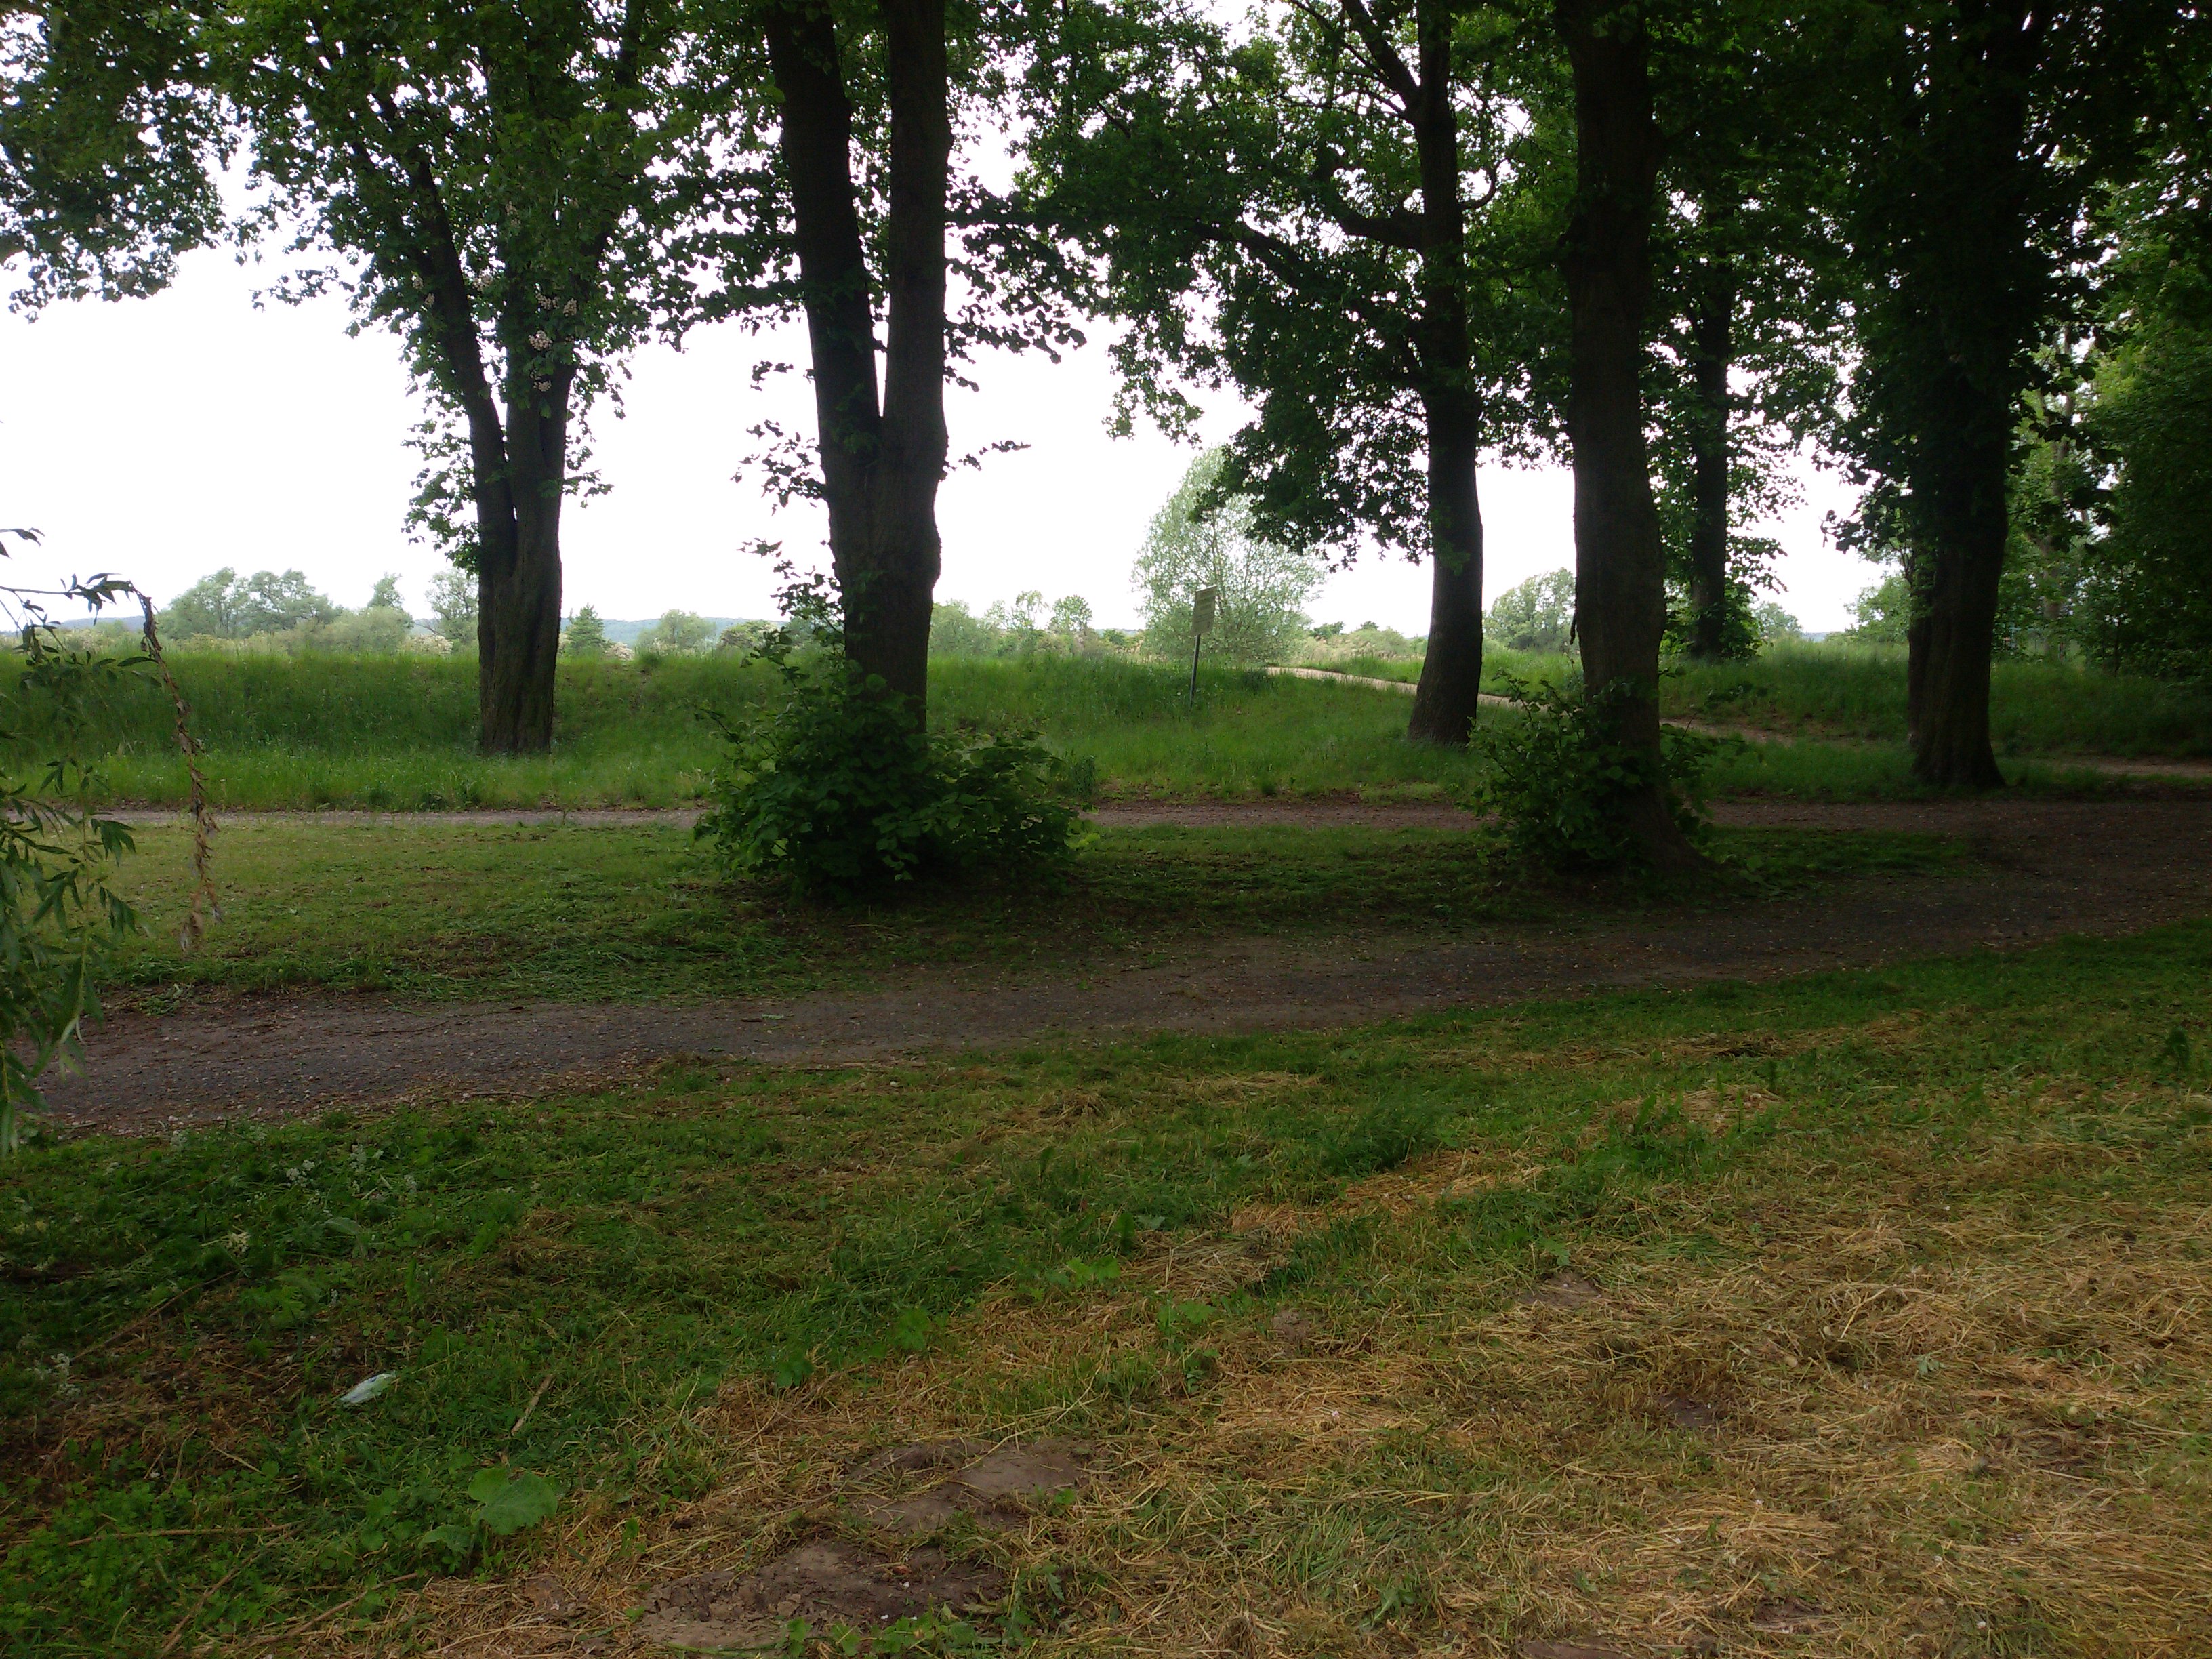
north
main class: Grassland
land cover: Grassland with sparse tree/shrub cover
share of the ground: > 75 %
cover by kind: herbaceous plants 95 %, broadleaved forest trees 5 %
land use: Amenities, museums, leisure
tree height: > 5 m
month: May
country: PL
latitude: 53.2470
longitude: 14.4821
